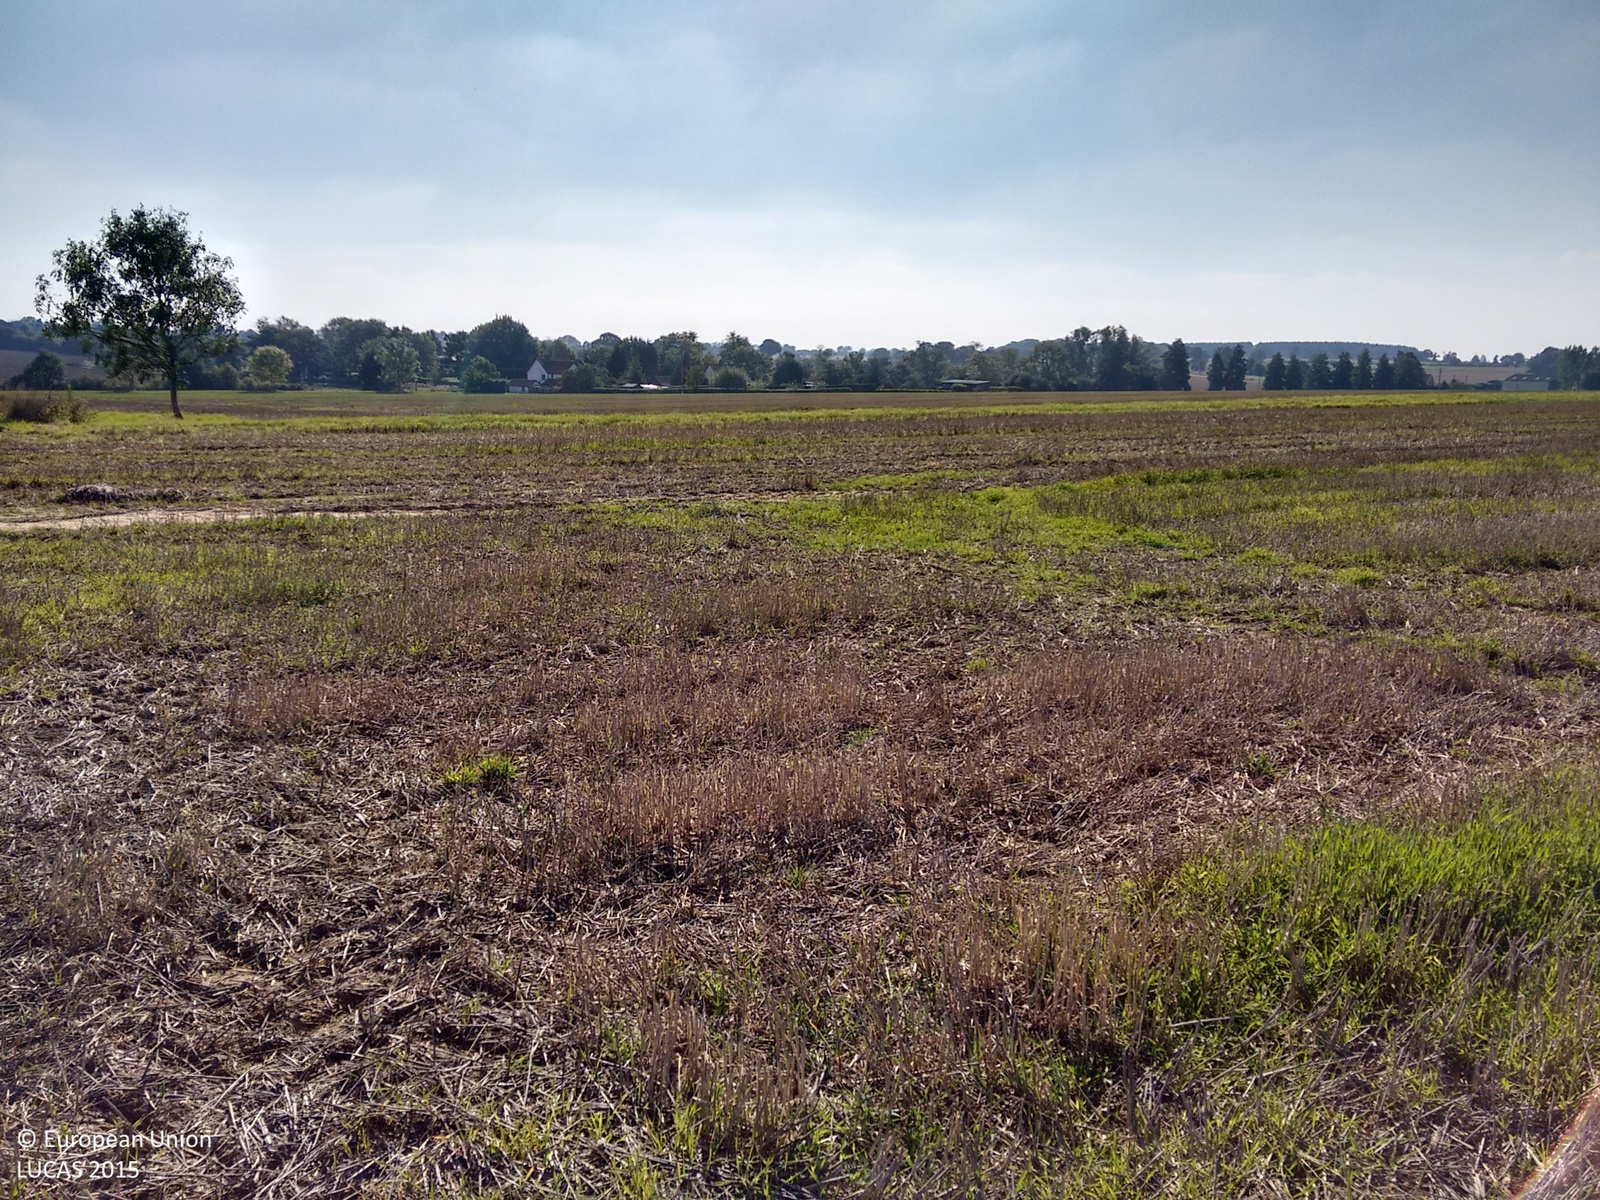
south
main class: Cropland
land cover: Common wheat
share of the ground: > 75 %
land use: Agriculture (excluding fallow land and kitchen gardens)
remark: Harvested field
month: October
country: GB
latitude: 52.3566
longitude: 0.9464
